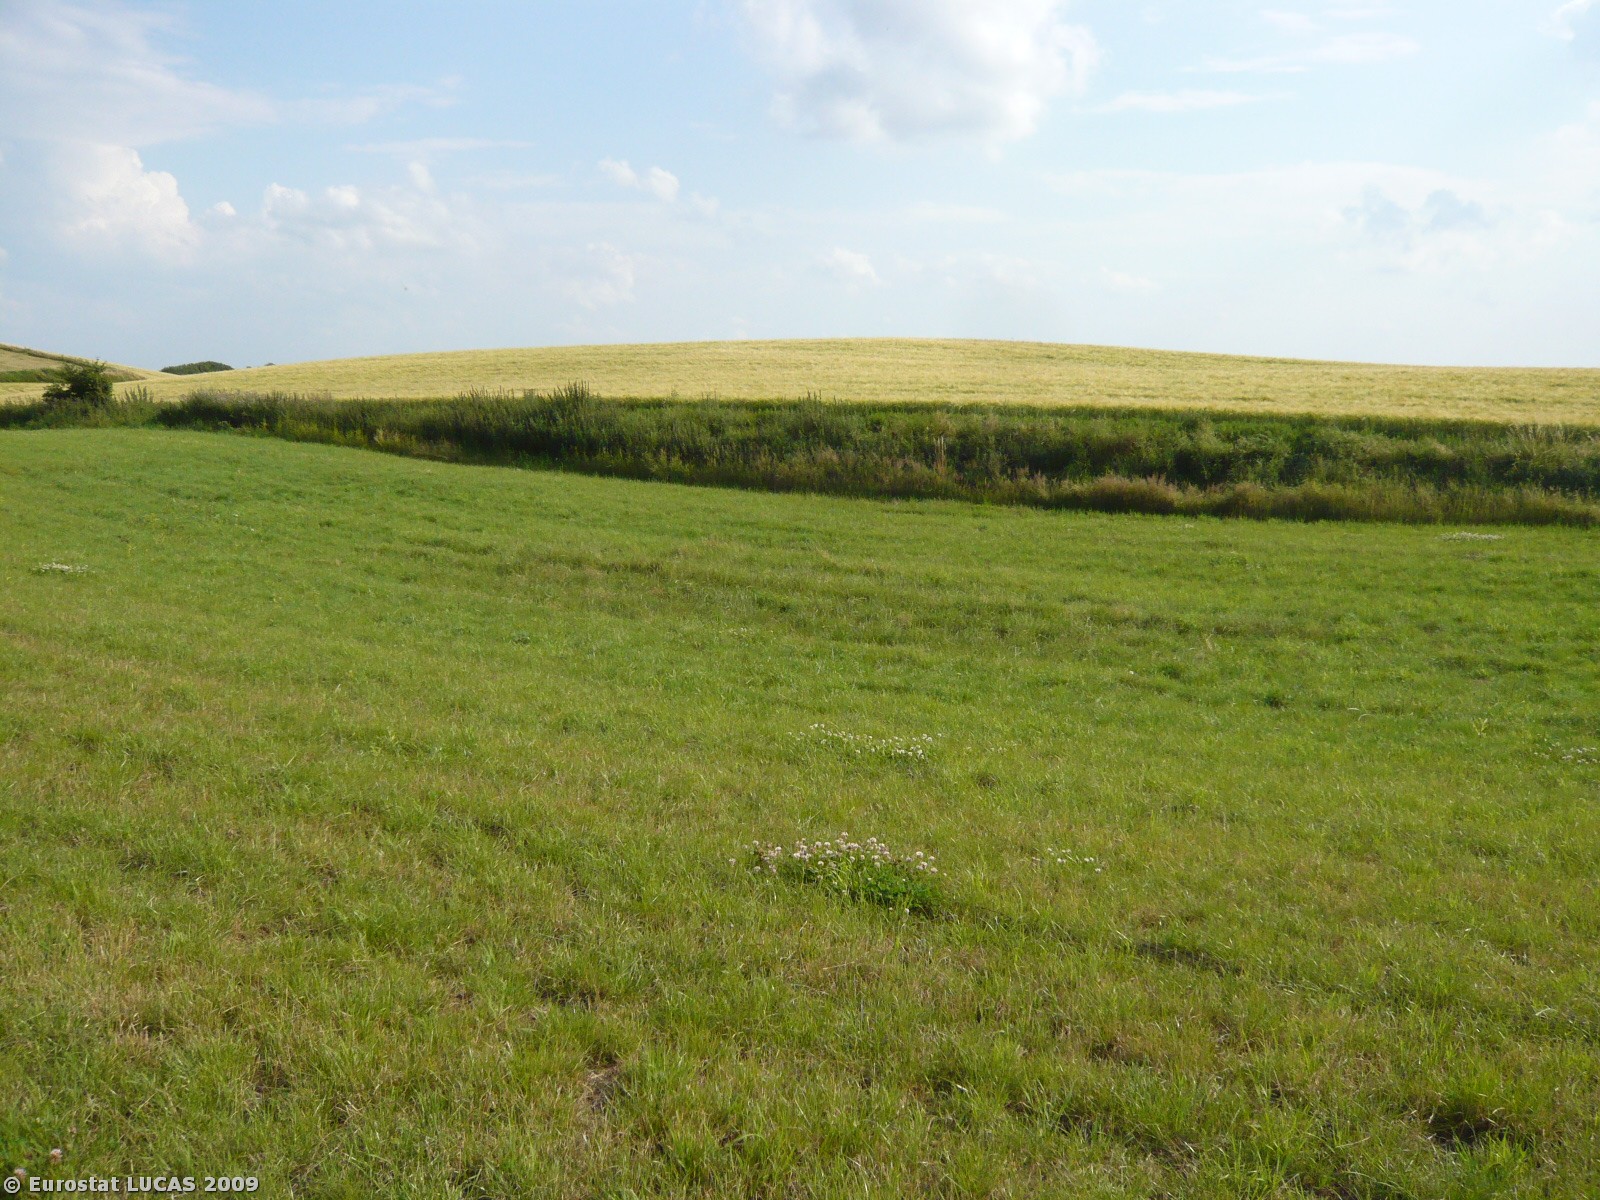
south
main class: Grassland
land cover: Grassland without tree/shrub cover
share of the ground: > 75 %
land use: Agriculture (excluding fallow land and kitchen gardens)
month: July
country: DK
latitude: 55.8540
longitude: 11.6118
